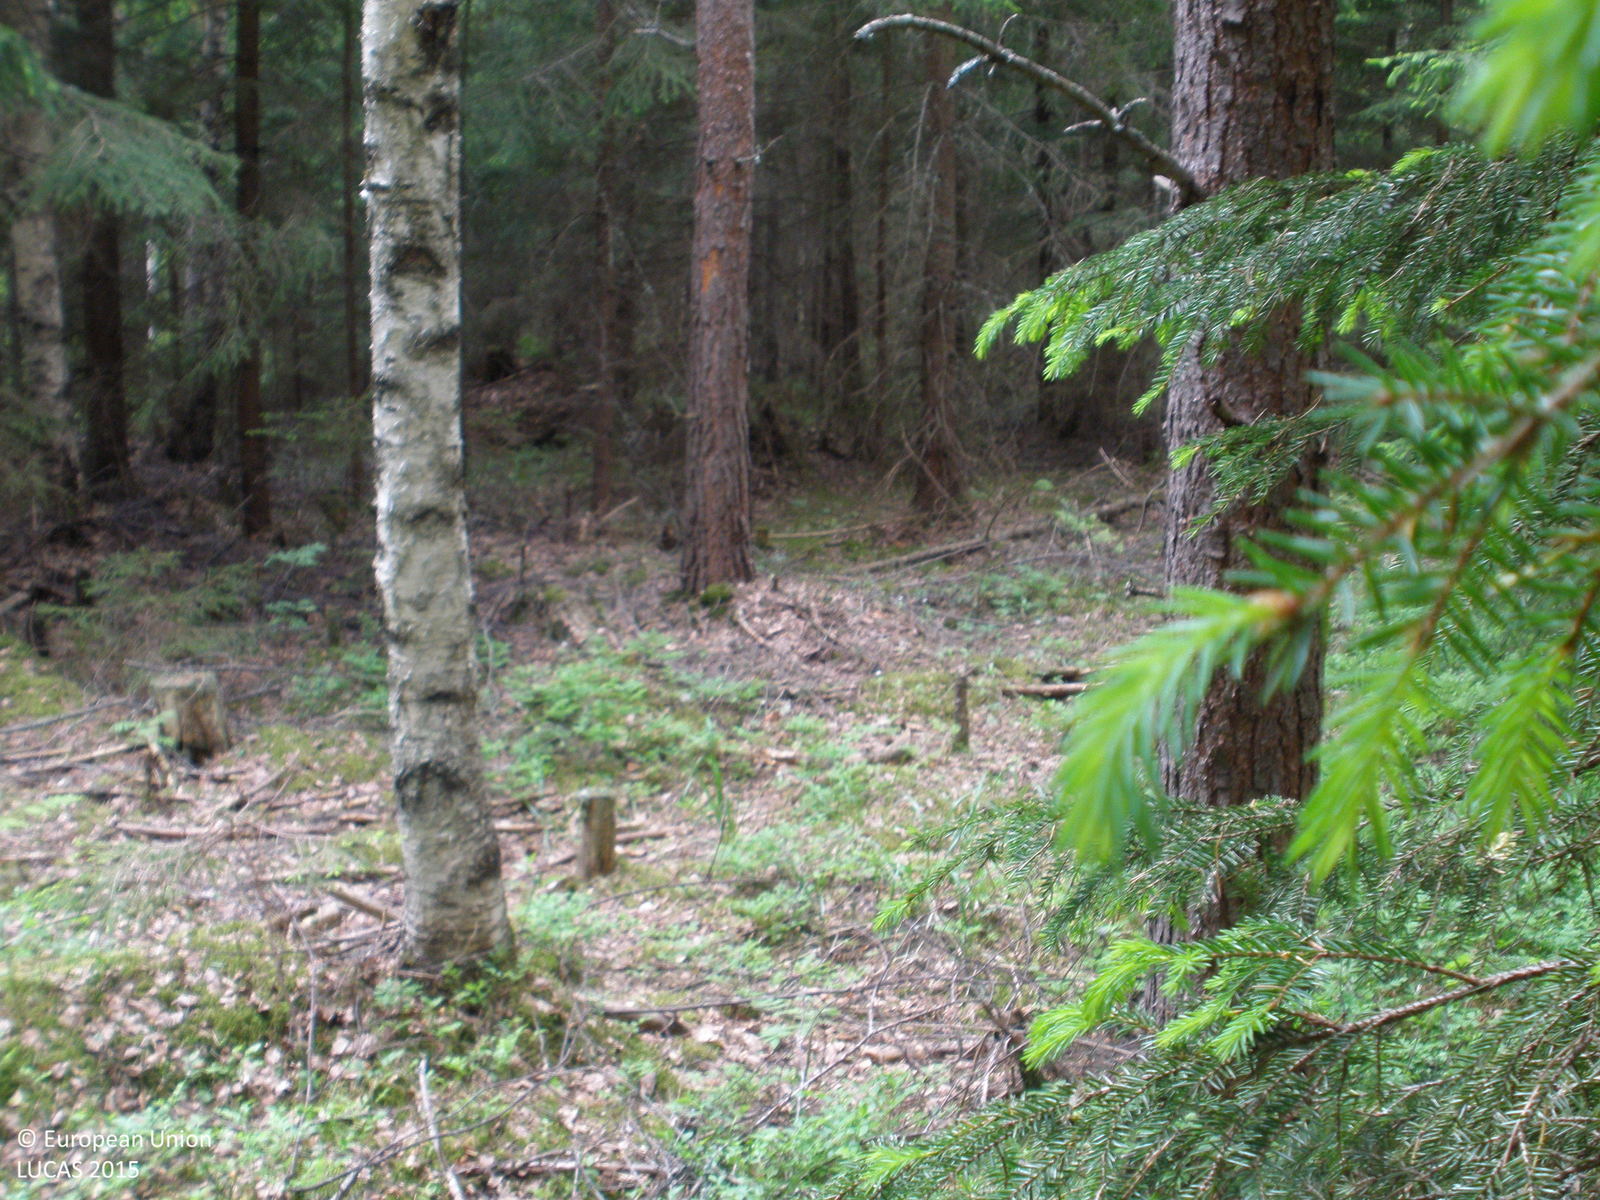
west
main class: Woodland
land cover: Pine dominated mixed woodland
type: boreal forest
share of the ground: > 75 %
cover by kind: coniferous forest trees 60 %, broadleaved forest trees 25 %, herbaceous plants 10 %, shrubs 5 %
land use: Forestry
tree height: > 5 m
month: June
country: FI
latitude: 61.0152
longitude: 24.2117
